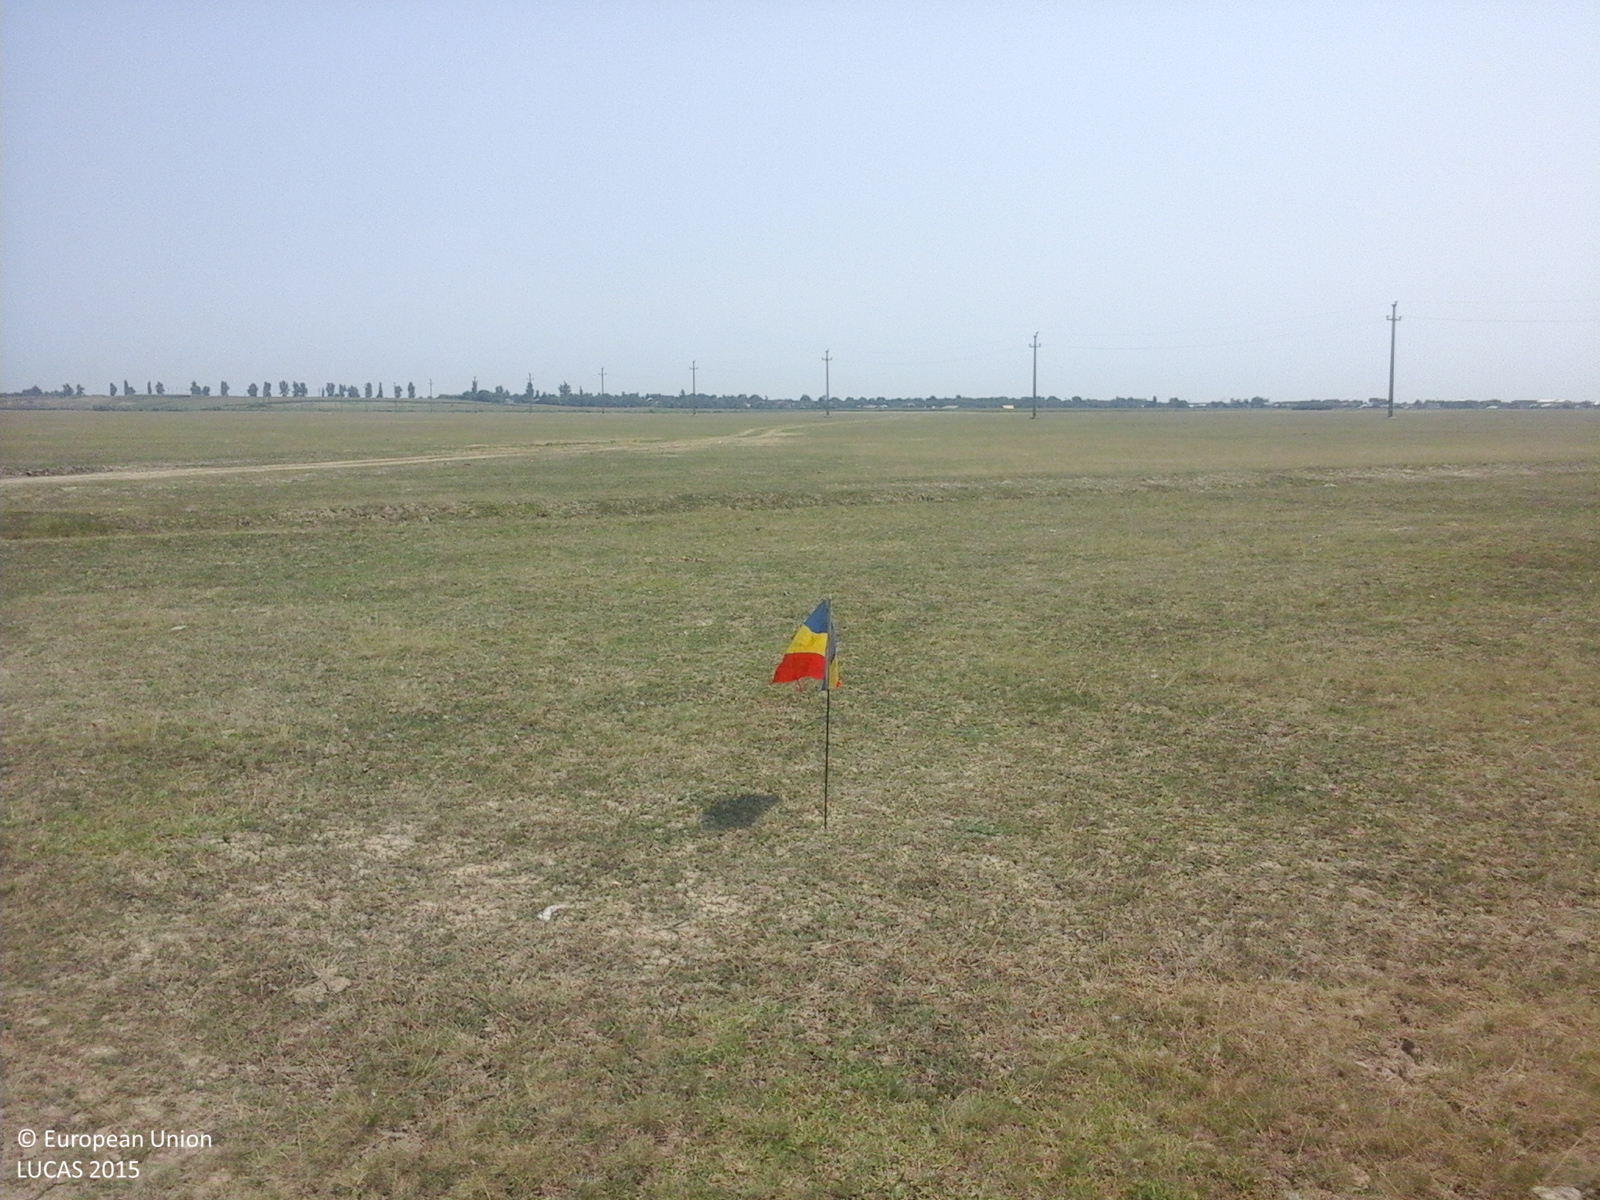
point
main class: Grassland
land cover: Grassland without tree/shrub cover
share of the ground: > 75 %
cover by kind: herbaceous plants 100 %
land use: Agriculture (excluding fallow land and kitchen gardens)
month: July
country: RO
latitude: 44.7558
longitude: 26.5544
